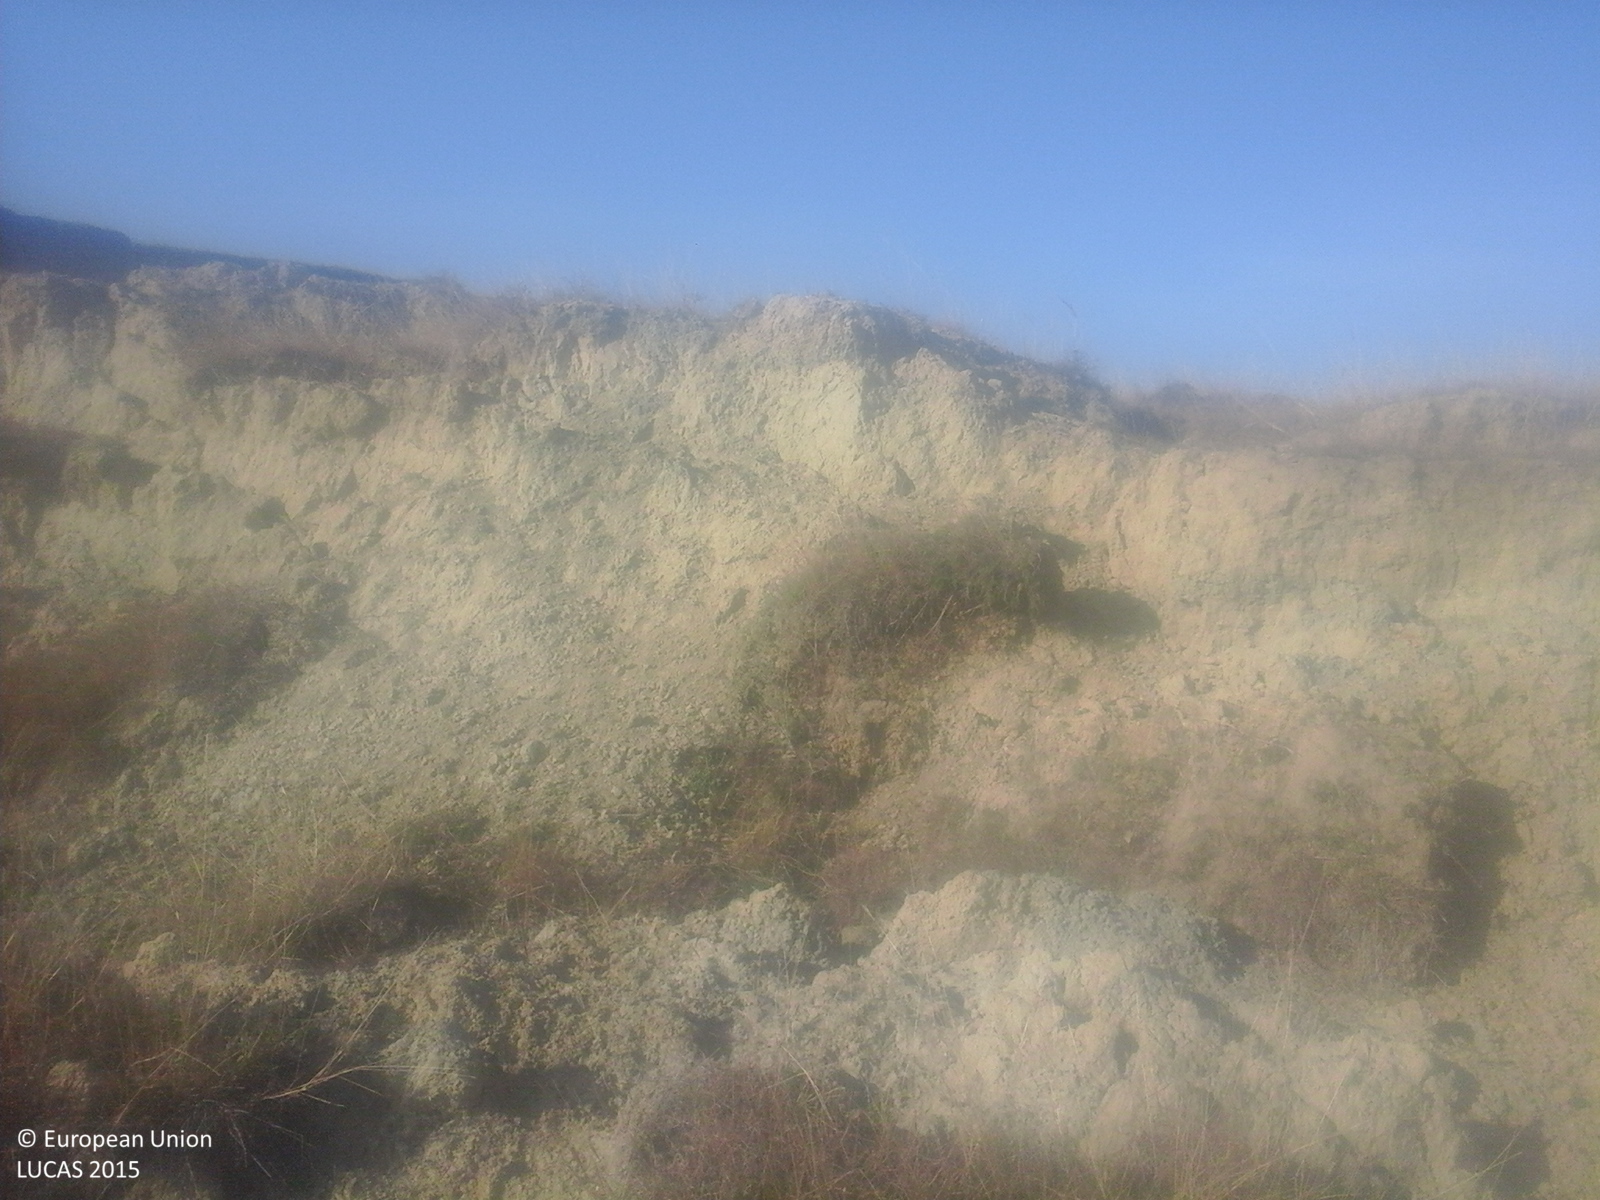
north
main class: Grassland
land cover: Grassland without tree/shrub cover
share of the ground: 50 - 75 %
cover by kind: herbaceous plants 100 %
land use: Agriculture (excluding fallow land and kitchen gardens)
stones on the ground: < 10 %
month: October
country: RO
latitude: 45.3527
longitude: 26.8419
